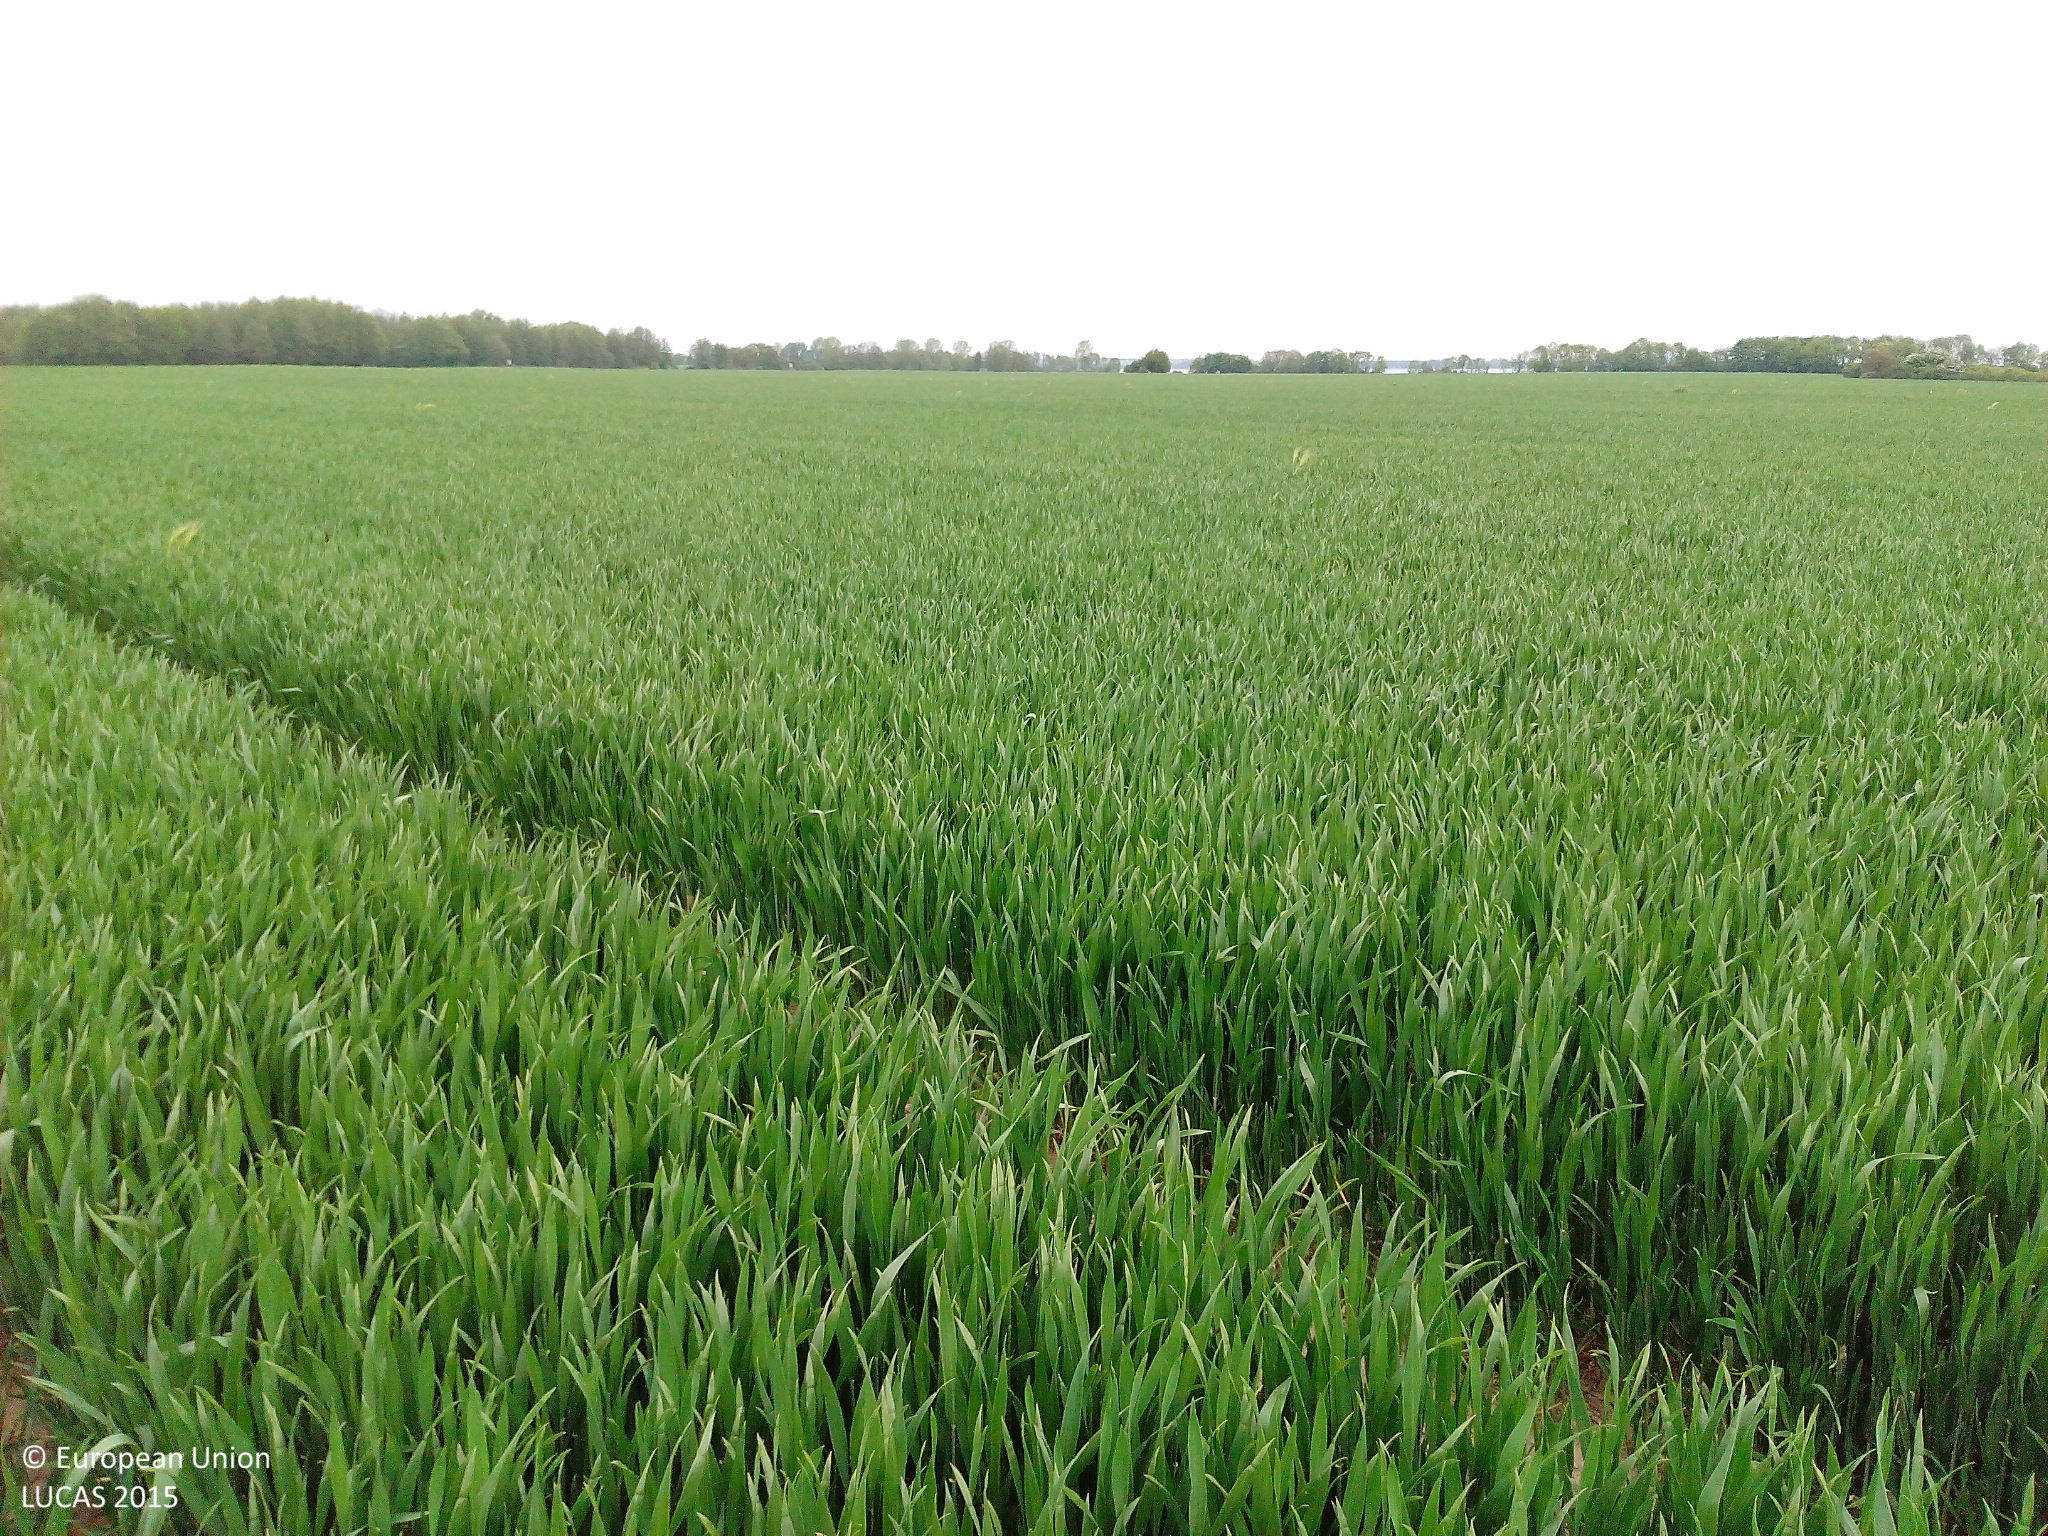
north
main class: Cropland
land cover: Barley
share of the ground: > 75 %
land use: Agriculture (excluding fallow land and kitchen gardens)
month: May
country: DE
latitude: 54.2026
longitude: 13.2952
